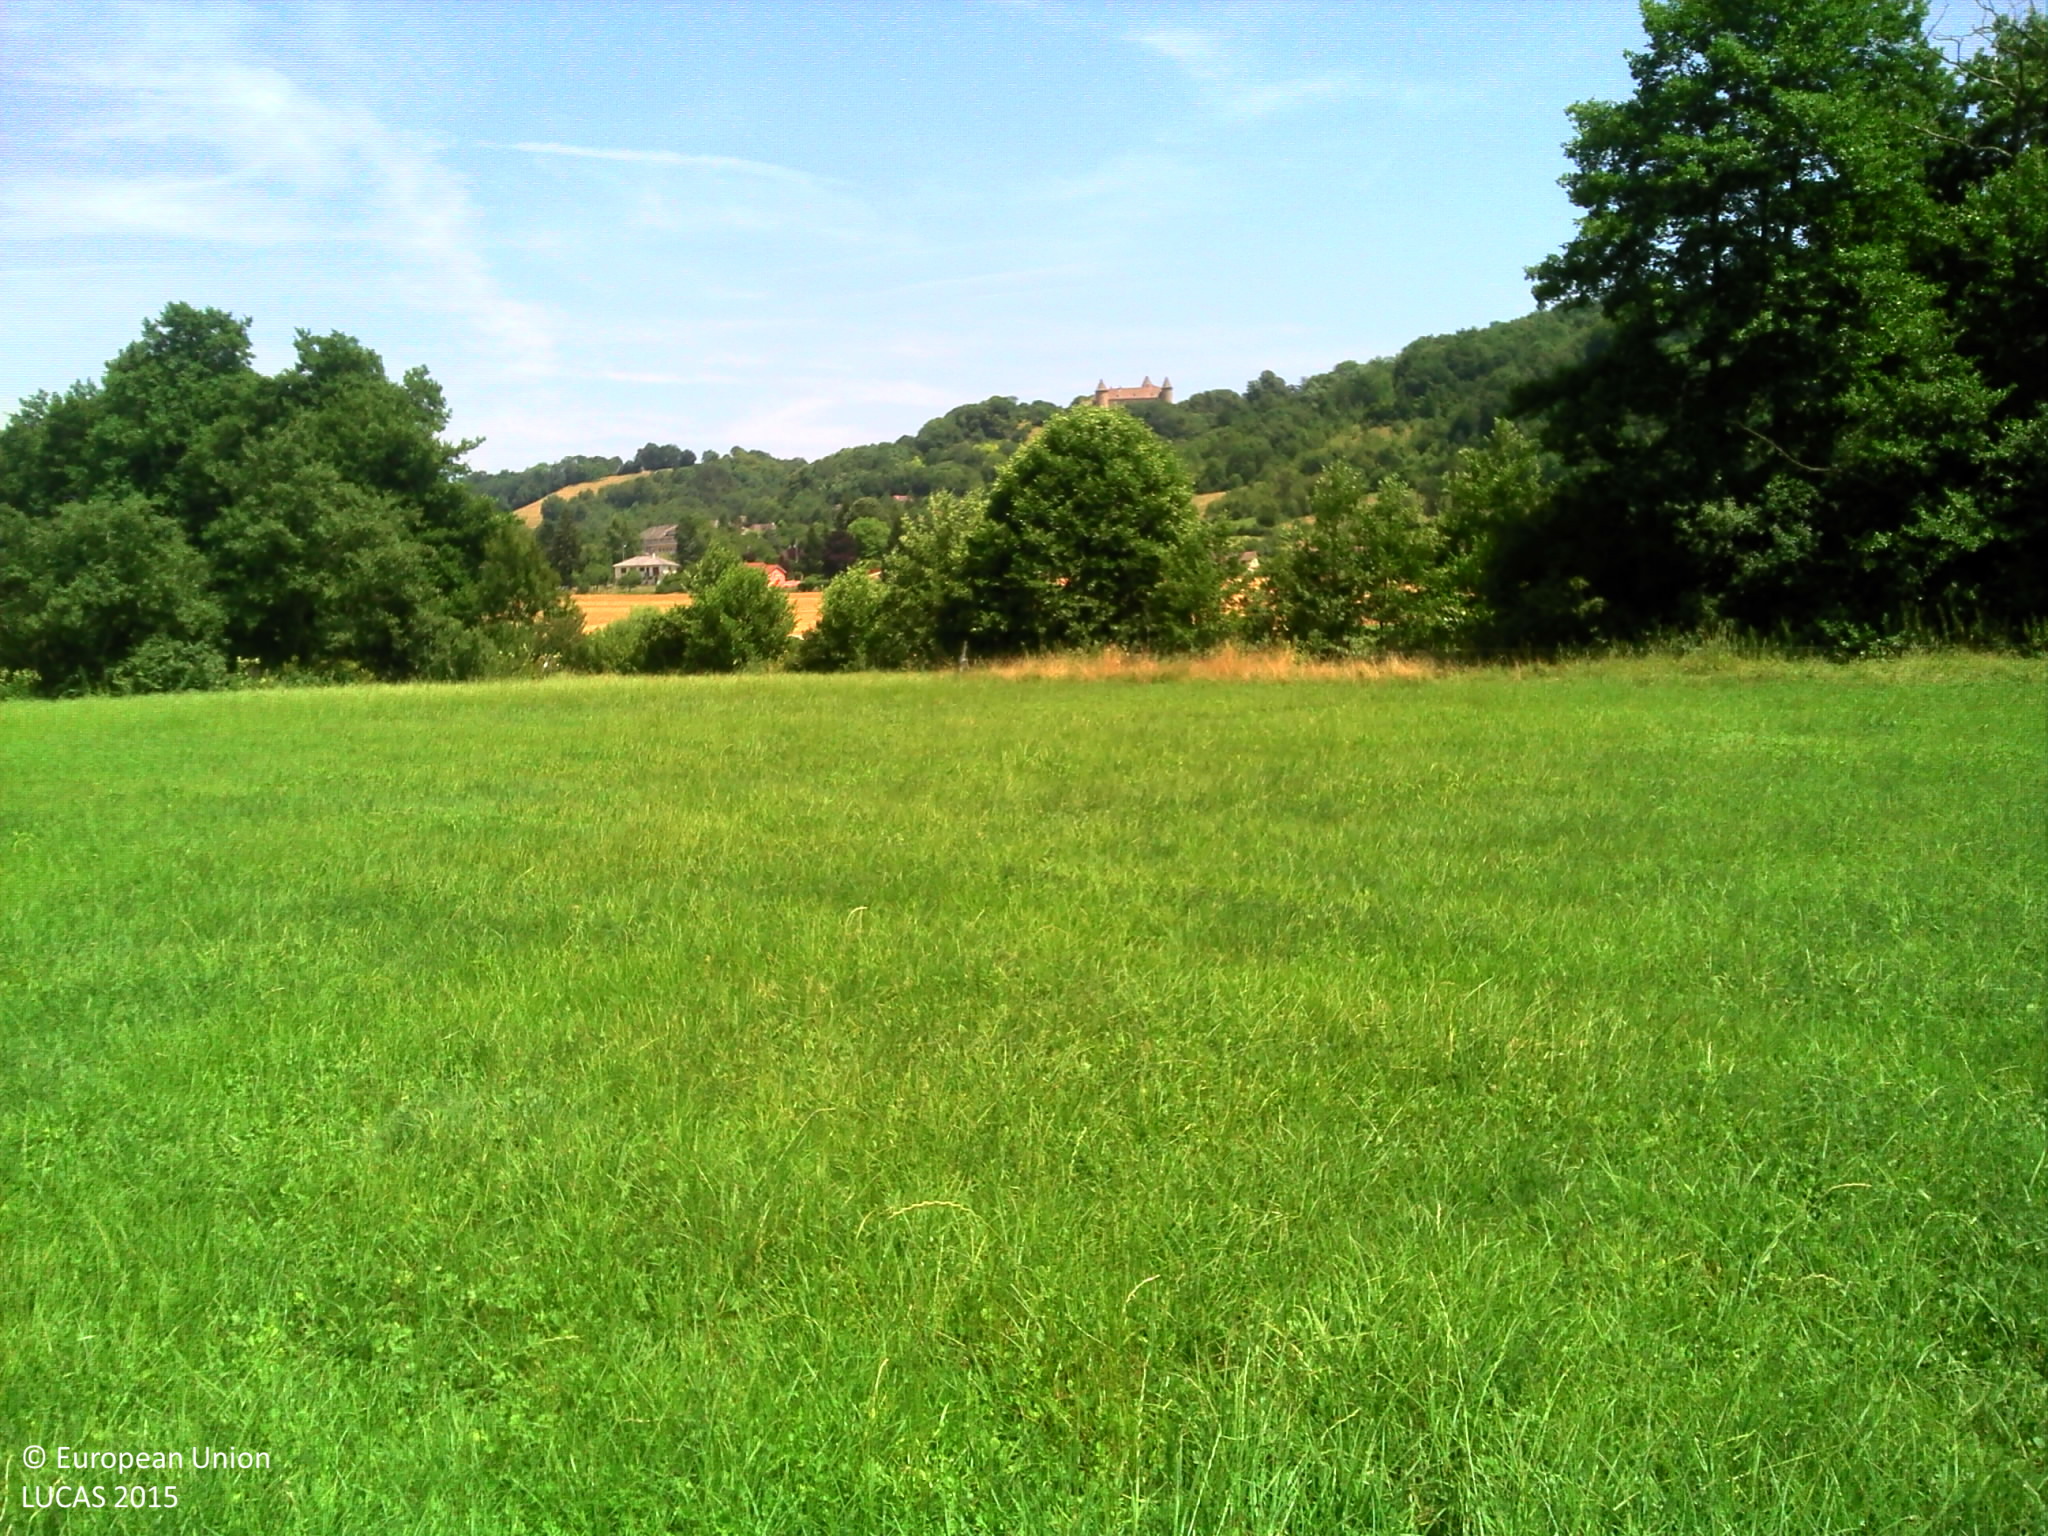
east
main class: Grassland
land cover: Grassland without tree/shrub cover
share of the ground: > 75 %
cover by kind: herbaceous plants 100 %
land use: Agriculture (excluding fallow land and kitchen gardens)
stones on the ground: < 10 %
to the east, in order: Grassland without tree/shrub cover; Fences; Tracks; Rivers and streams; Abandoned hedges; Grassland without tree/shrub cover; Fences; Grassland without tree/shrub cover; Electric lines; Grassland without tree/shrub cover; Tracks; Ditches and canals; Shruby margins; Maize
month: July
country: FR
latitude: 45.4791
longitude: 5.4632
